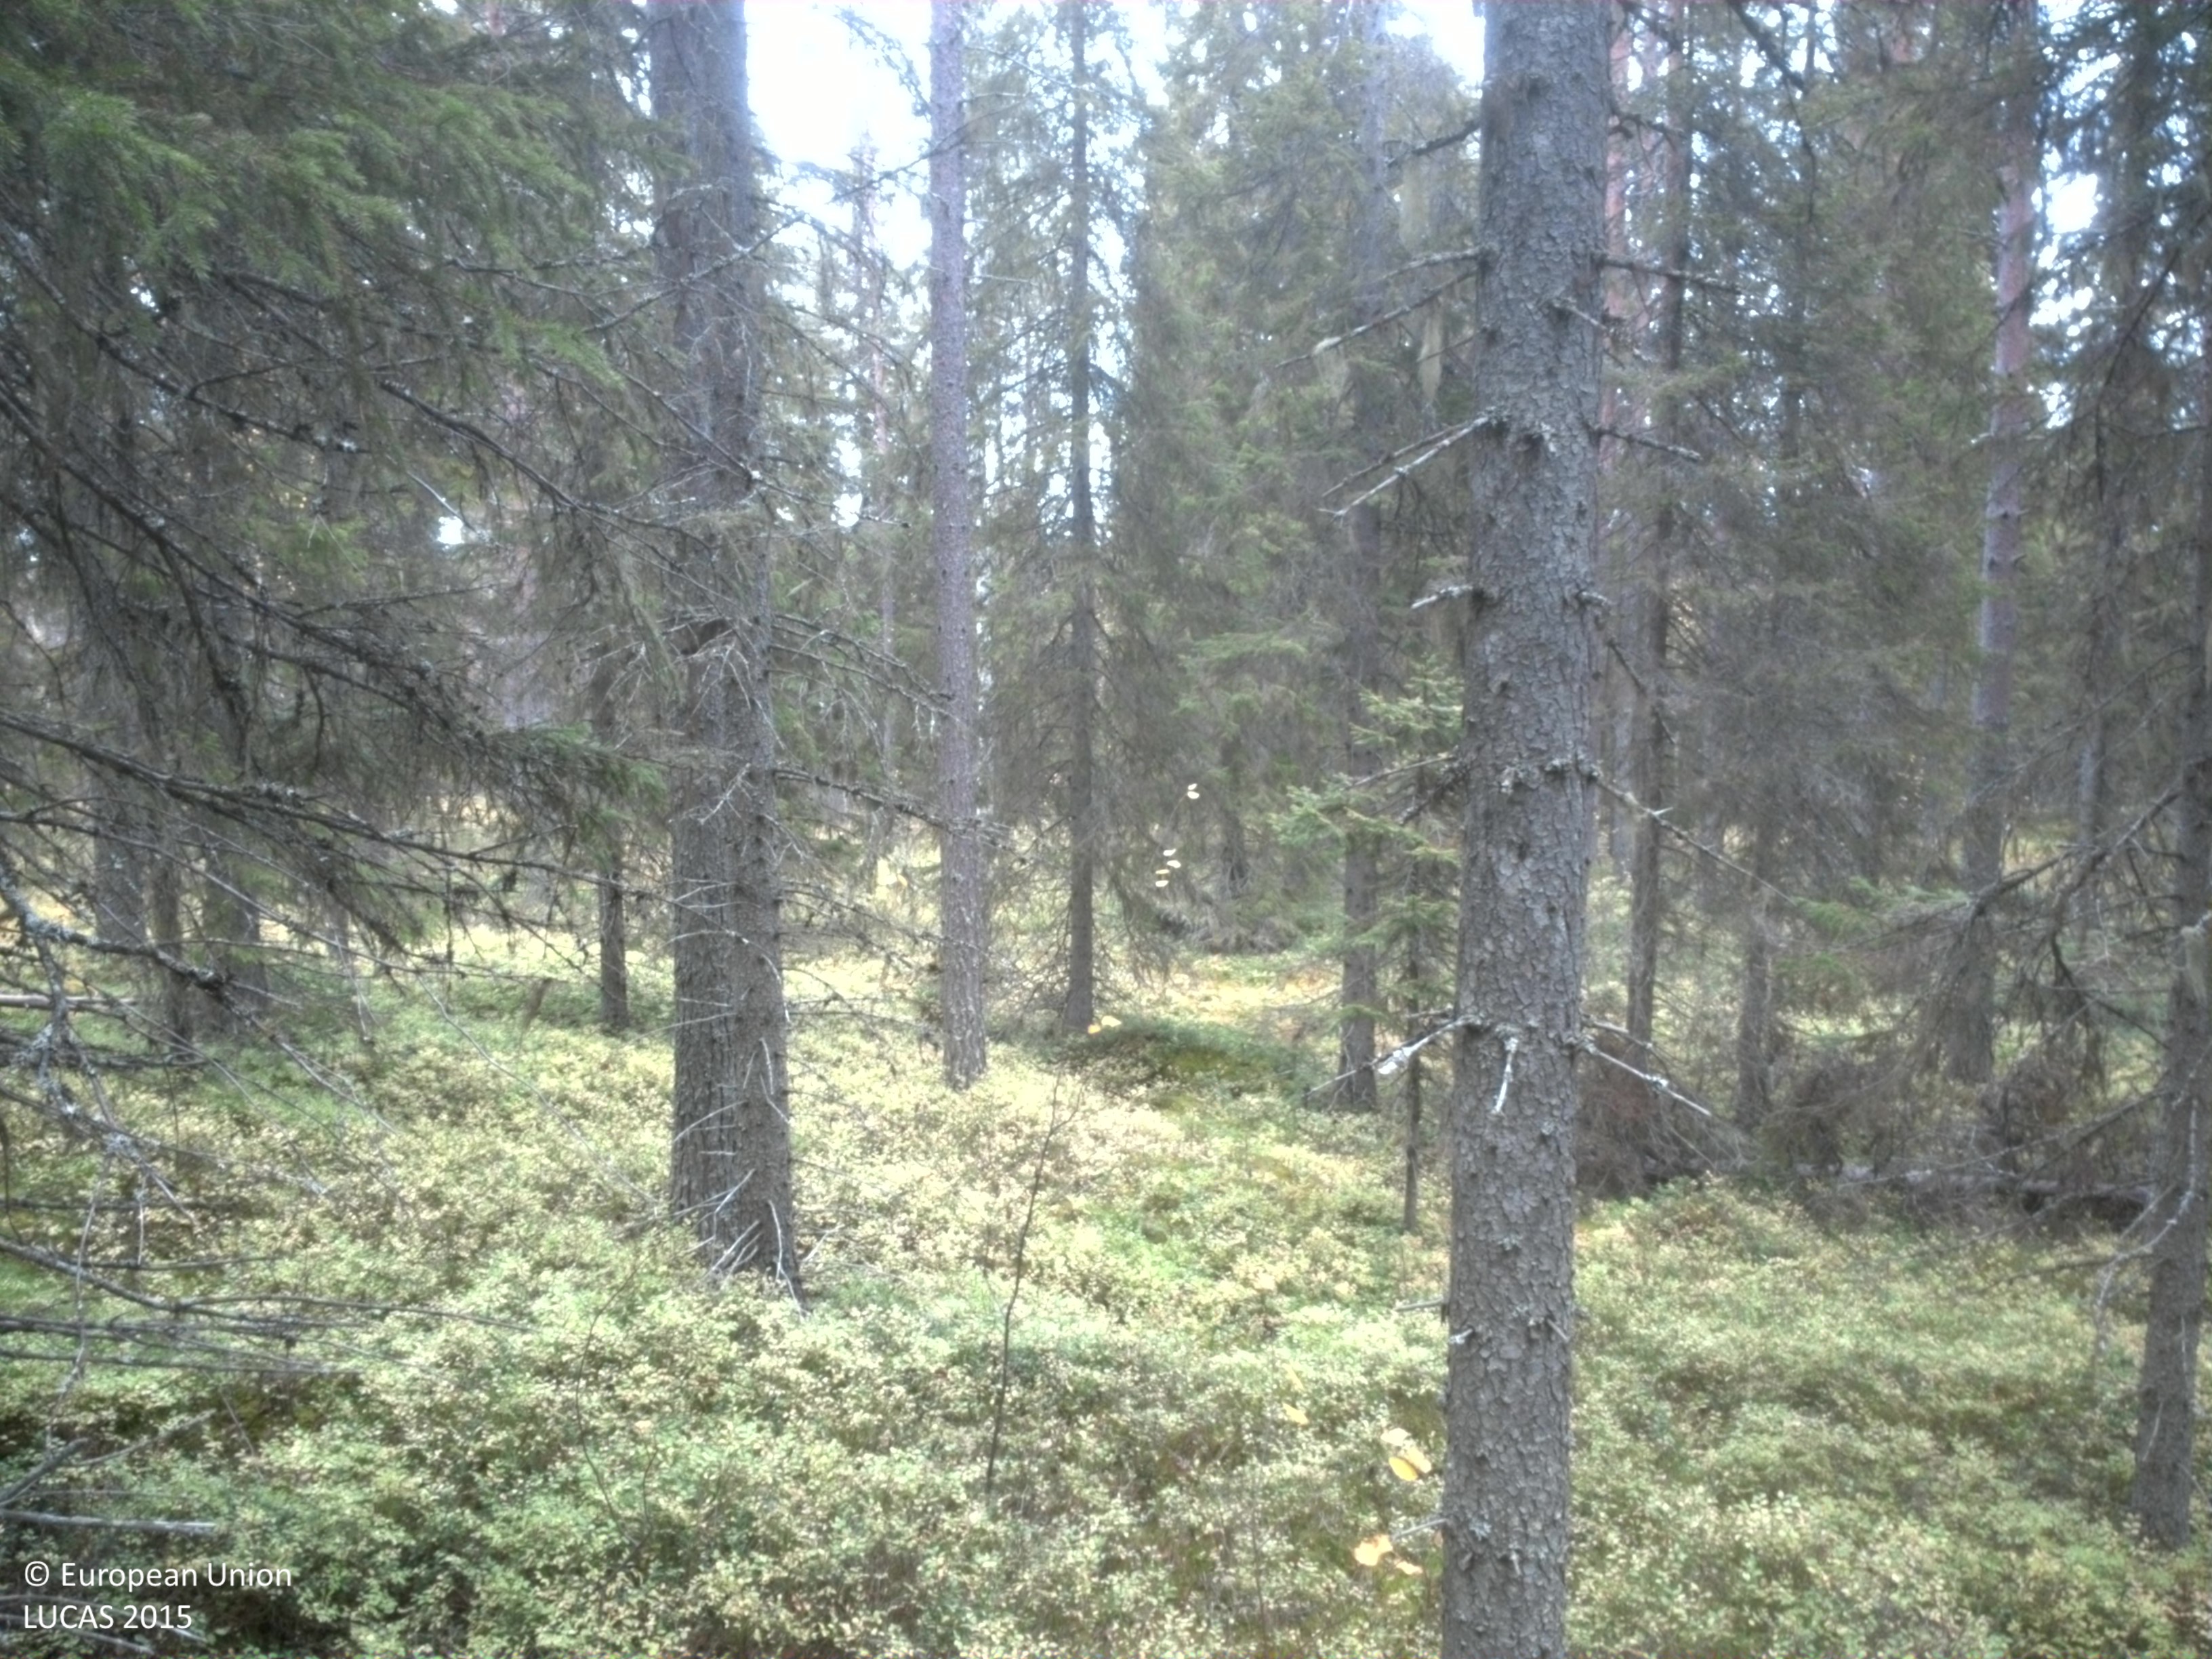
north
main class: Woodland
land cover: Spruce dominated coniferous woodland
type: boreal forest
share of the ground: 50 - 75 %
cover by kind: coniferous forest trees 60 %, shrubs 30 %, lichens and mosses 10 %
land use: Forestry
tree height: > 5 m
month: September
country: SE
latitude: 64.3437
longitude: 20.1819
